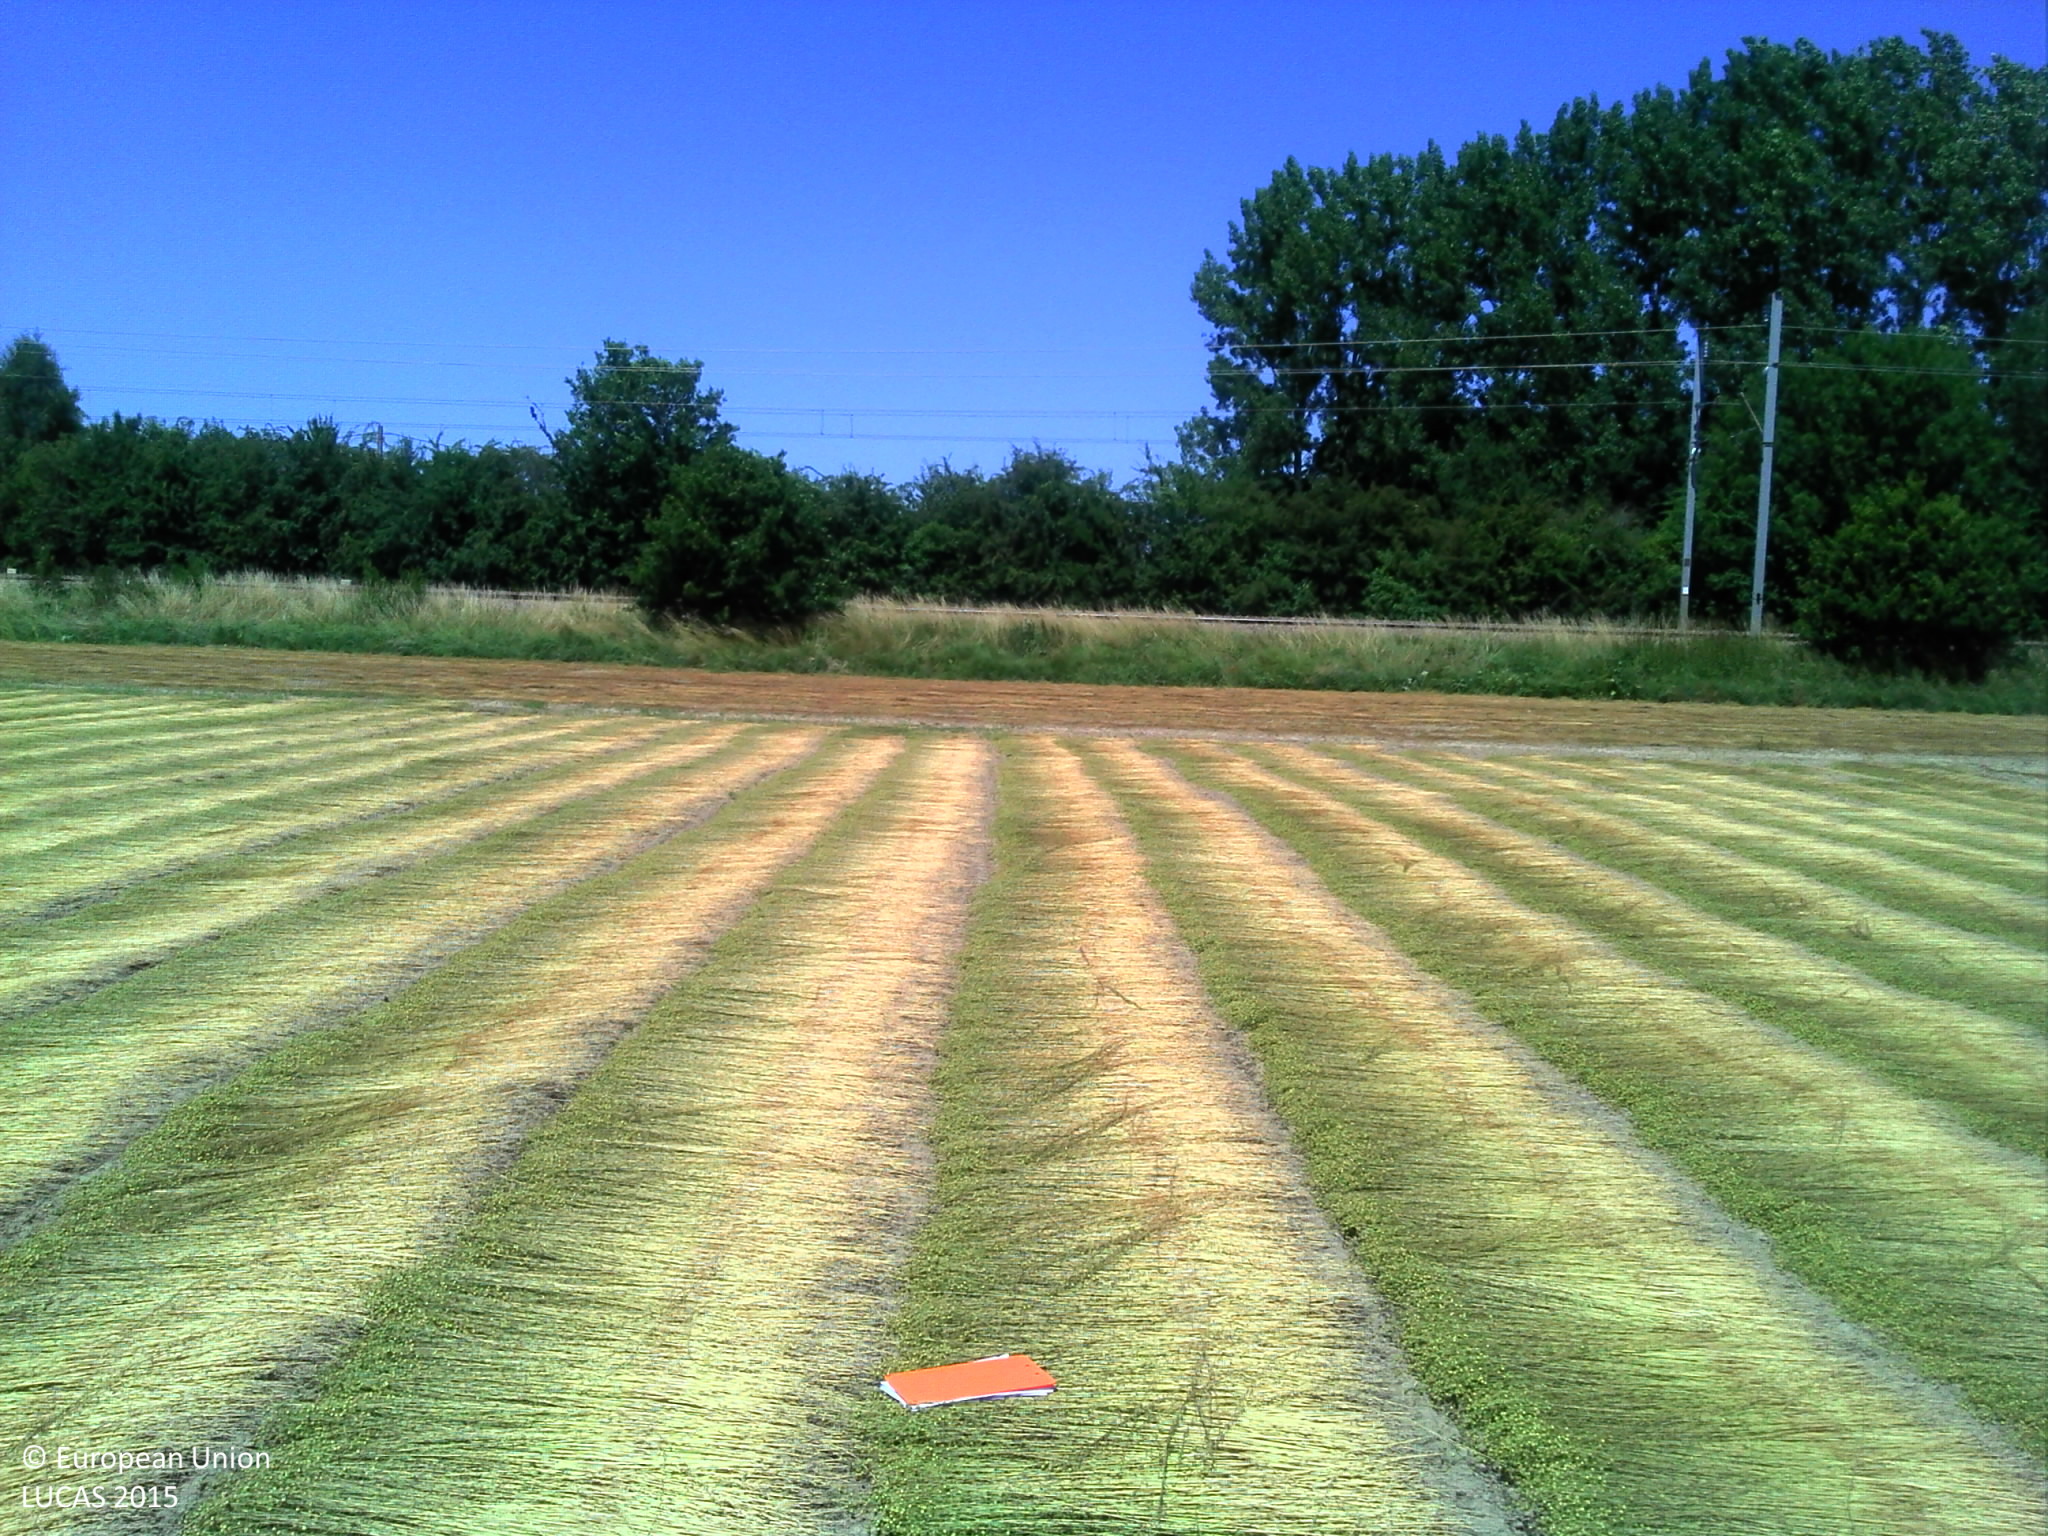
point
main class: Cropland
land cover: Other fibre and oleaginous crops
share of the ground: 25 - 50 %
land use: Agriculture (excluding fallow land and kitchen gardens)
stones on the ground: < 10 %
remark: Harvested field
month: July
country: FR
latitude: 49.0793
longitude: 0.4862
